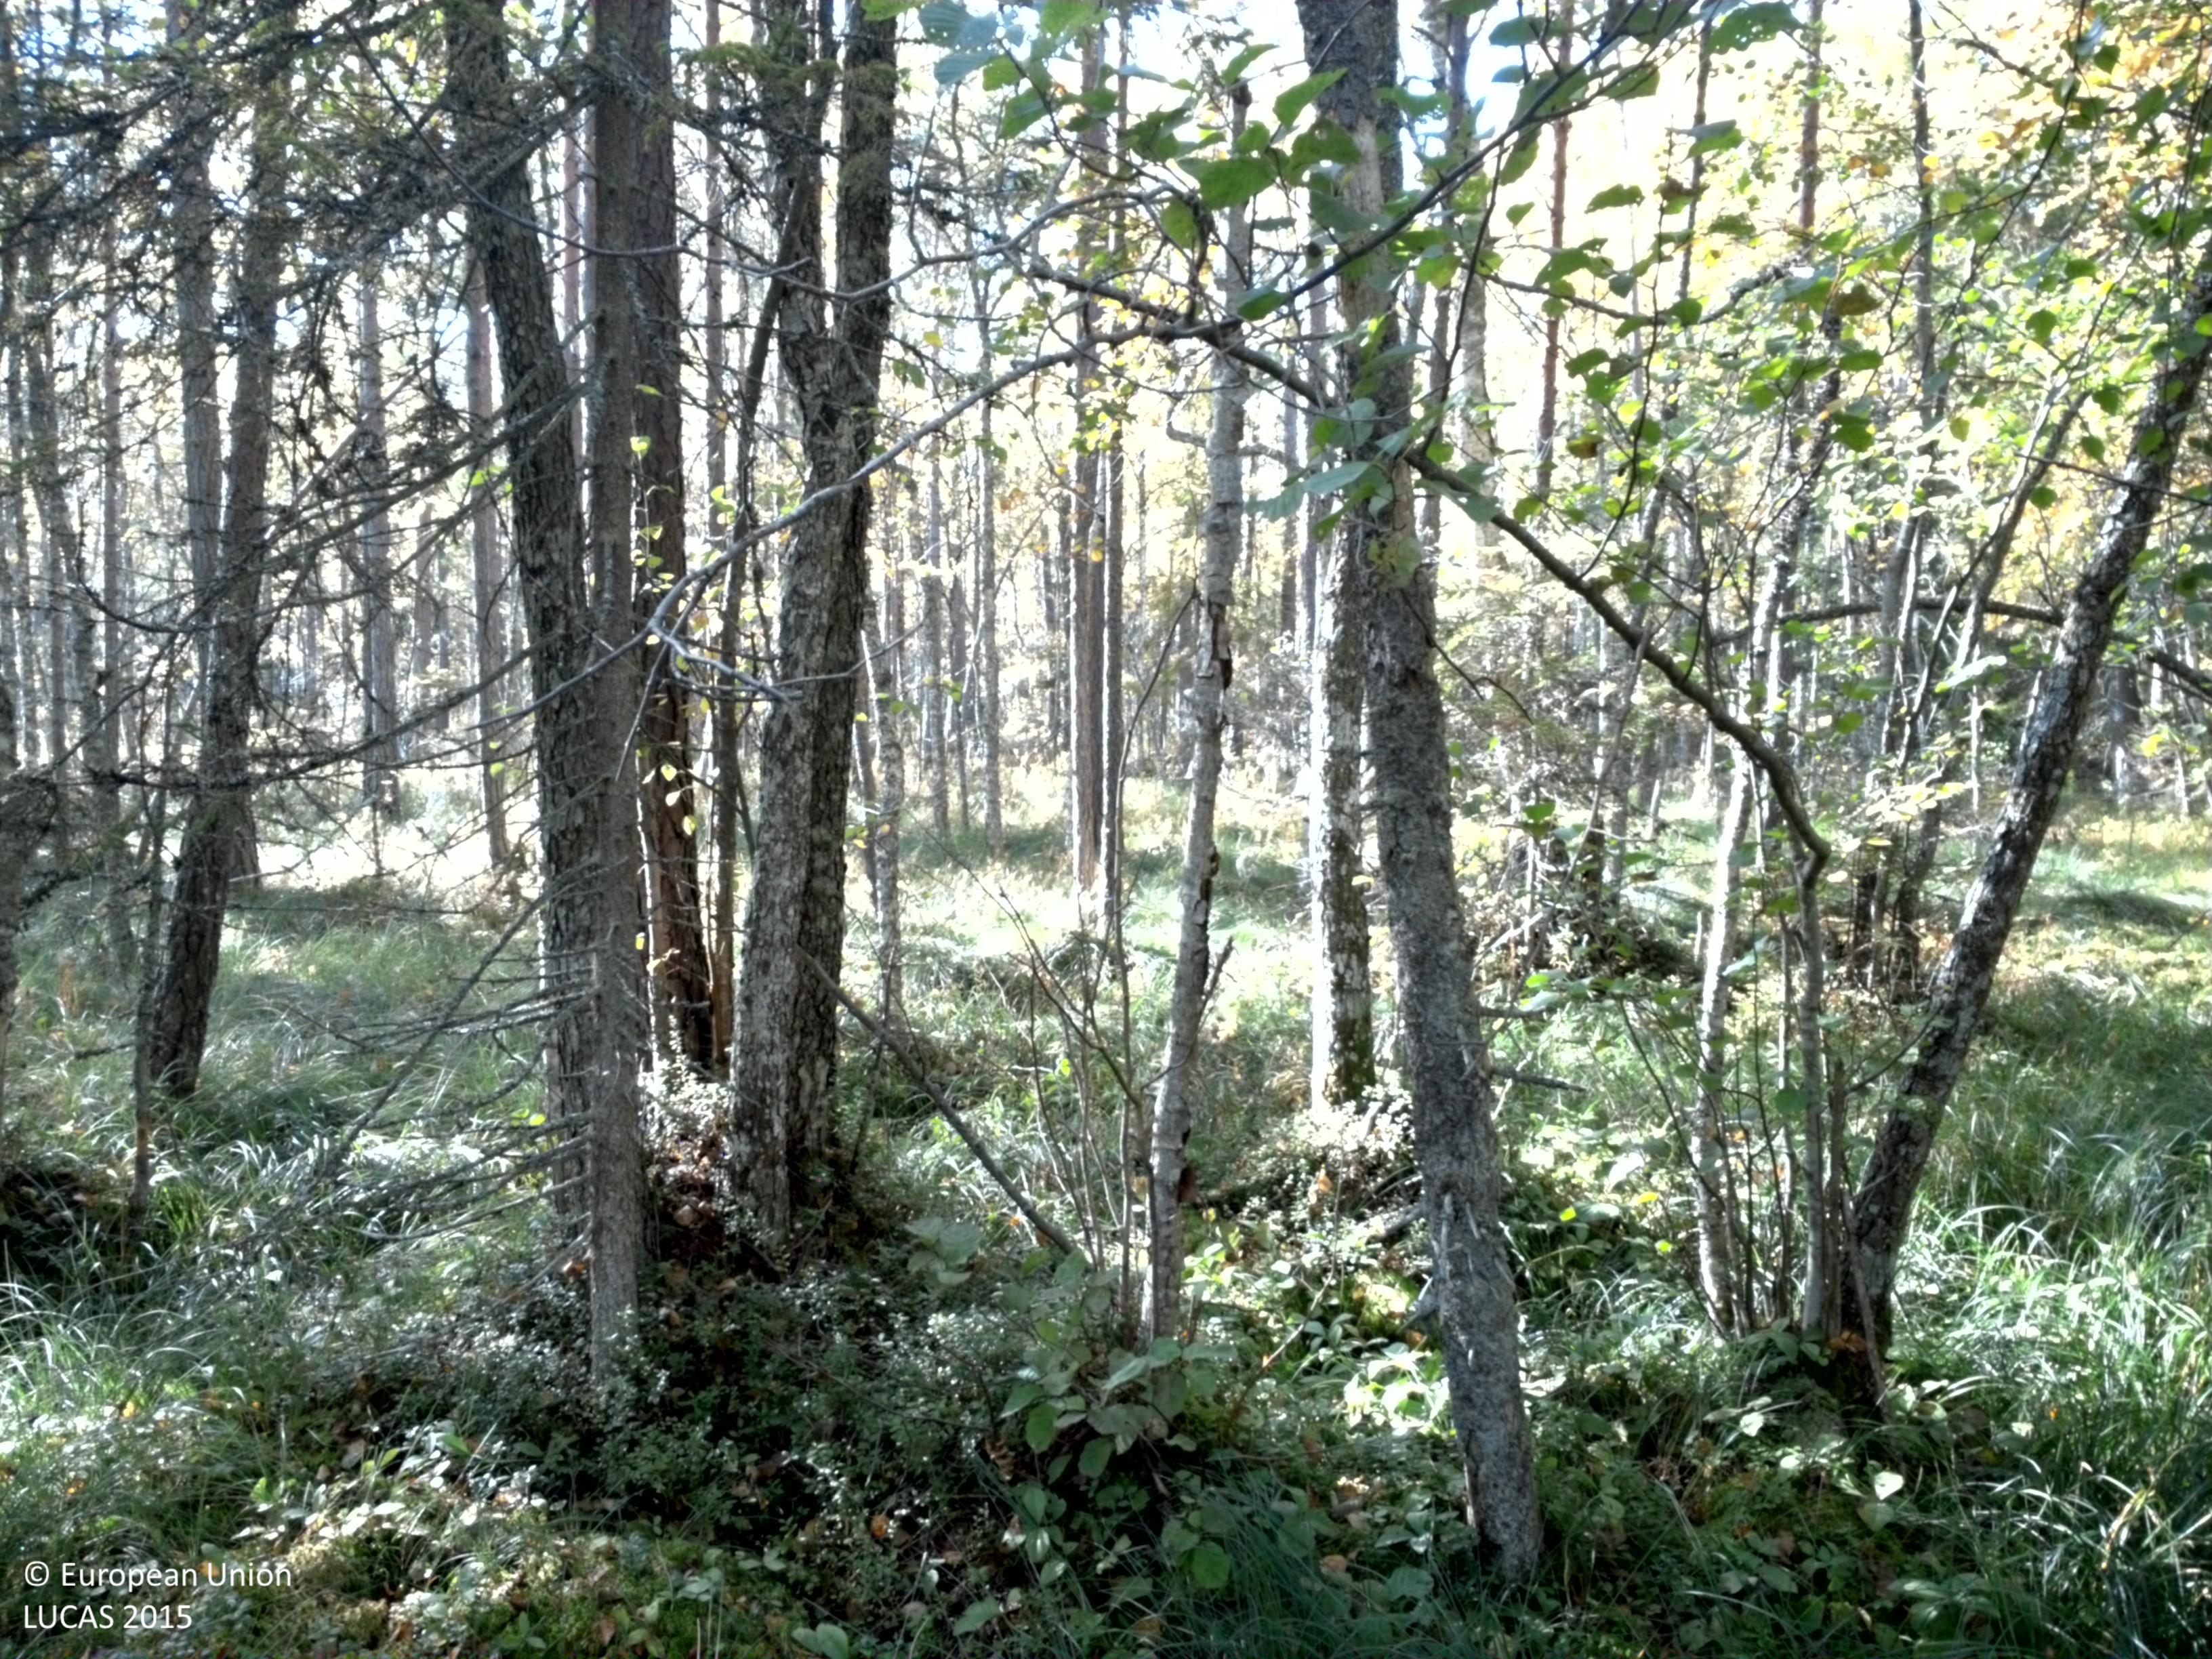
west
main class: Woodland
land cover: Pine dominated mixed woodland
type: boreal forest
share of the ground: 50 - 75 %
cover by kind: coniferous forest trees 45 %, broadleaved forest trees 25 %, shrubs 20 %, lichens and mosses 10 %
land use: Forestry
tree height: > 5 m
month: September
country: SE
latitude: 59.7930
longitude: 18.8568
